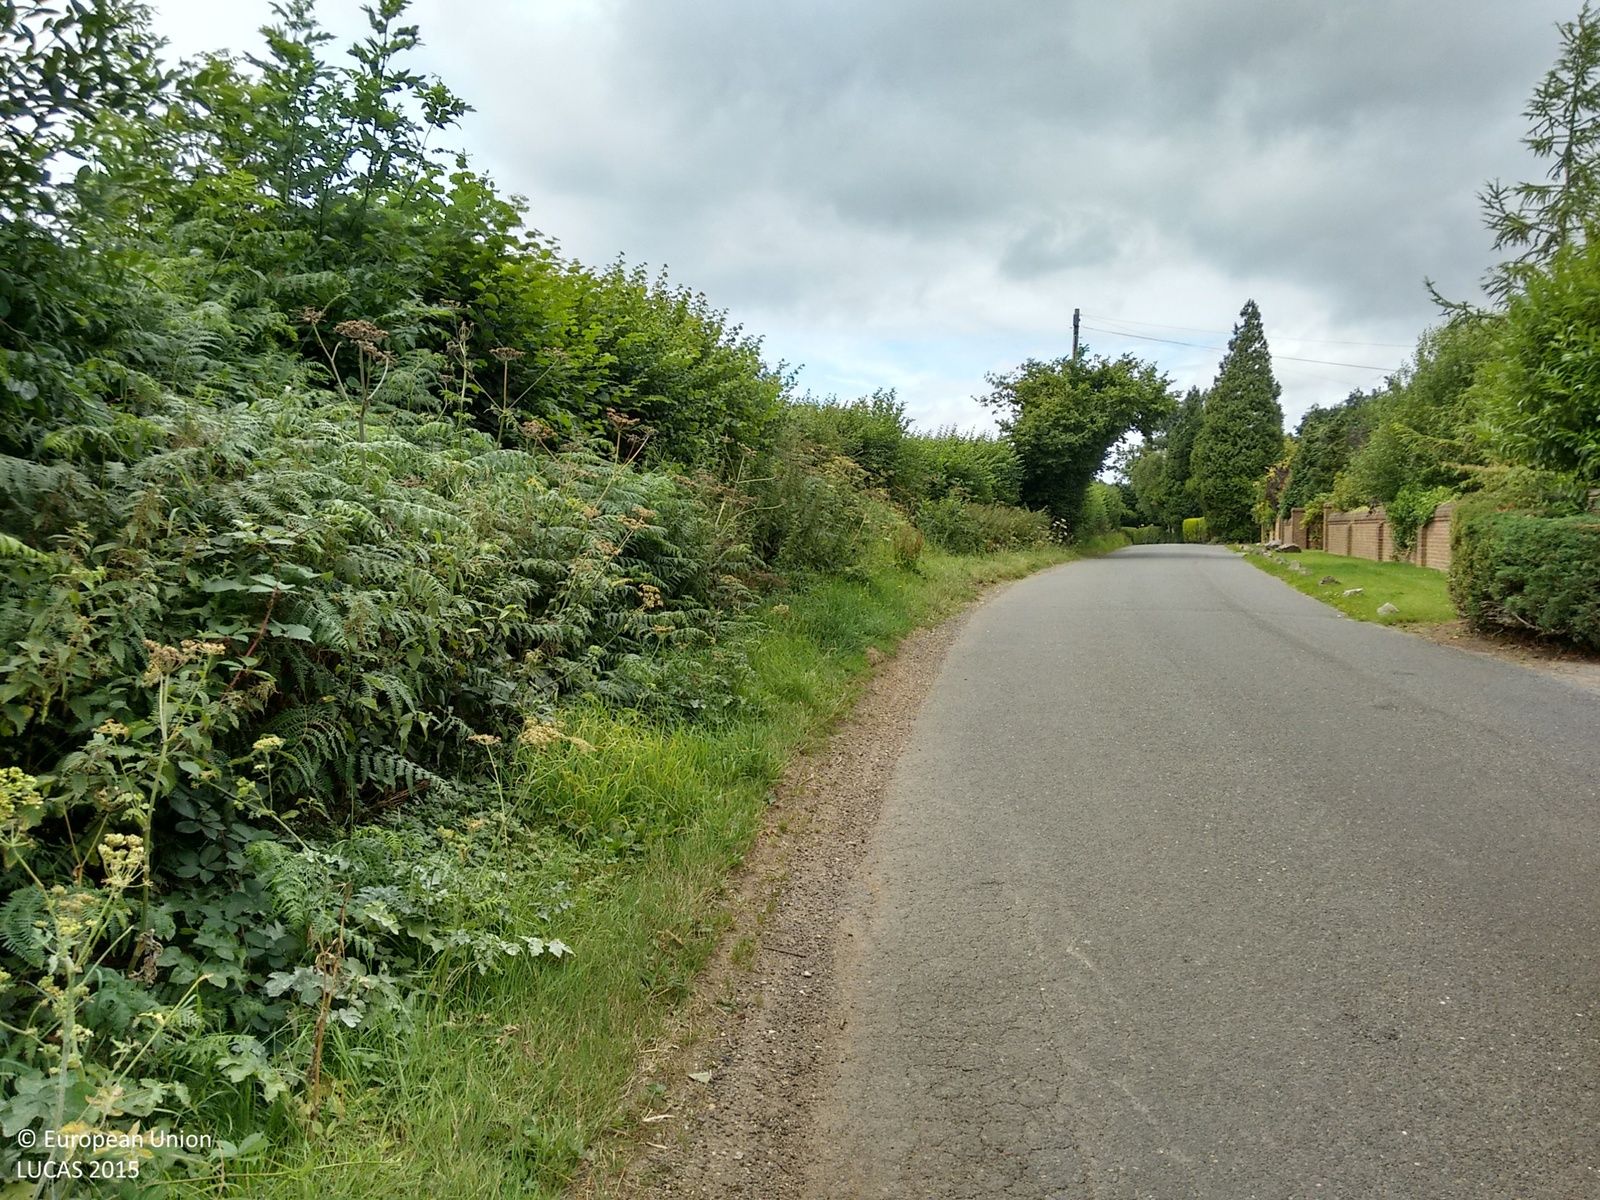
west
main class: Cropland
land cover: Common wheat
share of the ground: > 75 %
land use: Agriculture (excluding fallow land and kitchen gardens)
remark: Harvested field
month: August
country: GB
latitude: 51.2666
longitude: -0.1965
